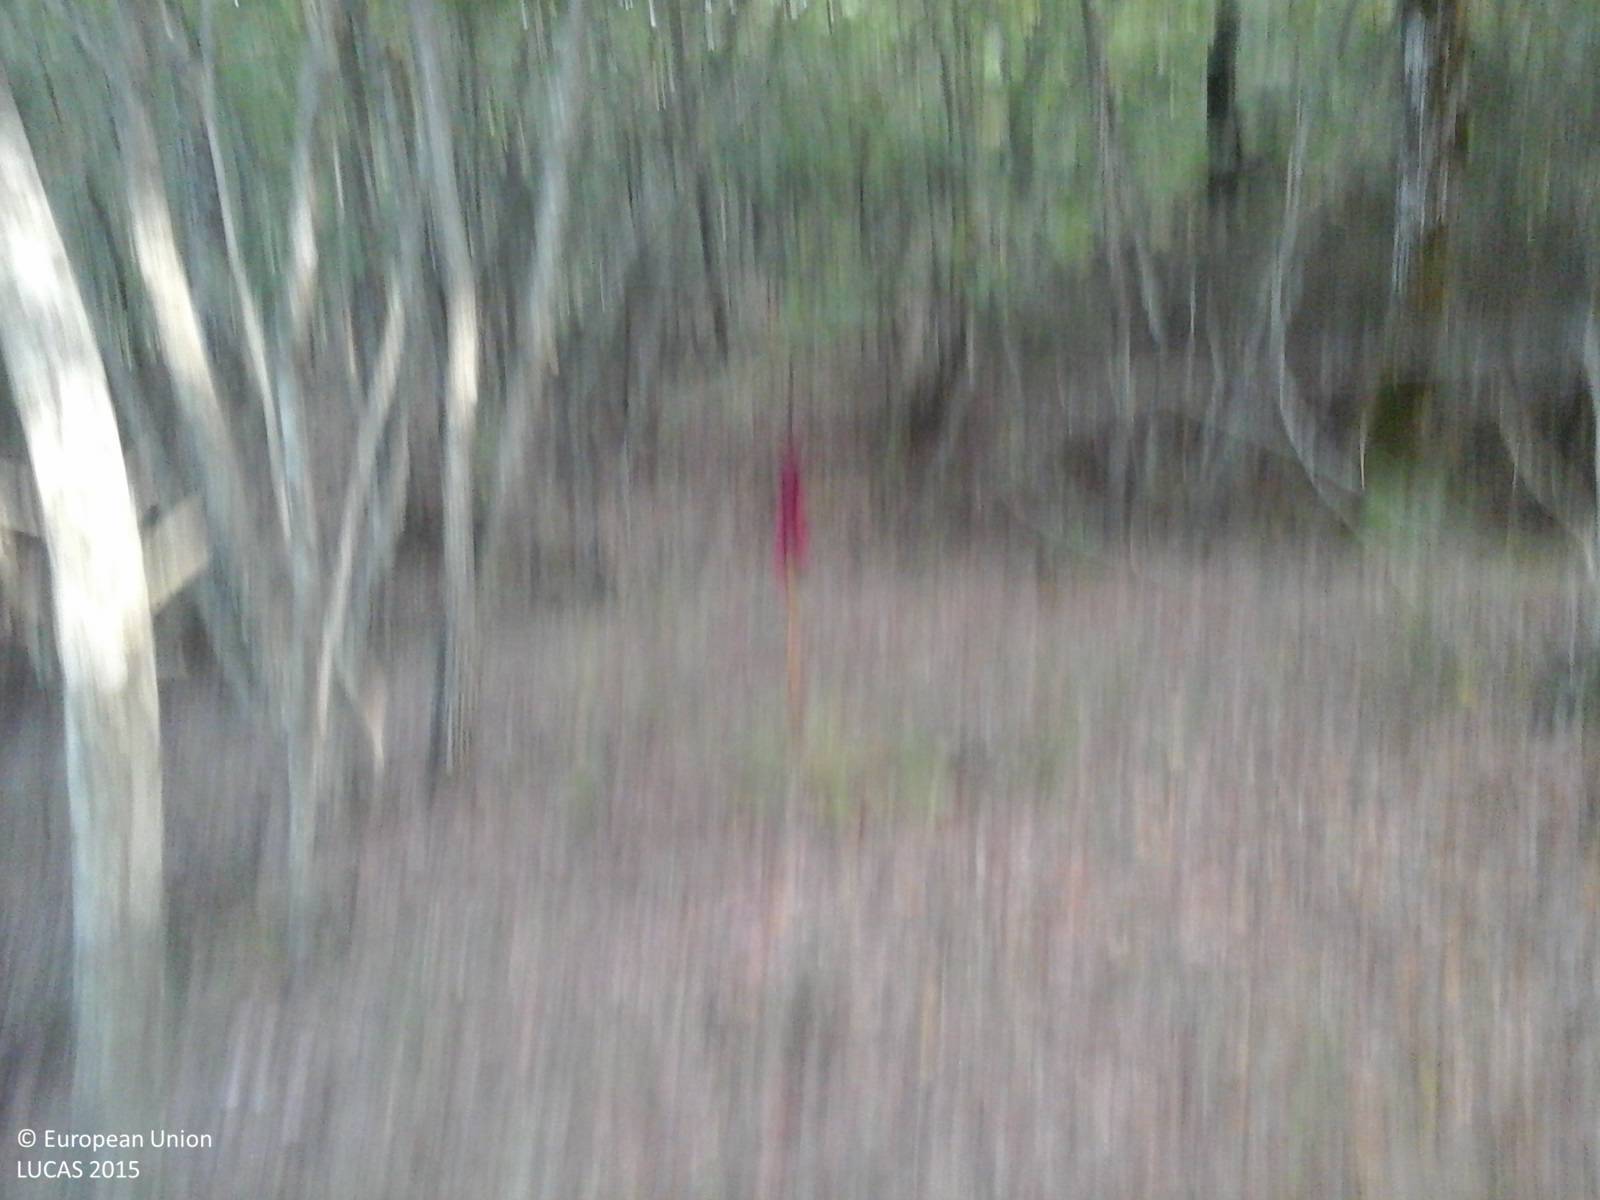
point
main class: Woodland
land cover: Broadleaved woodland
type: thermophilous deciduous forest
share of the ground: > 75 %
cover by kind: broadleaved forest trees 100 %
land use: Forestry
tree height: > 5 m
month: October
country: IT
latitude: 42.7915
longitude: 12.2546
